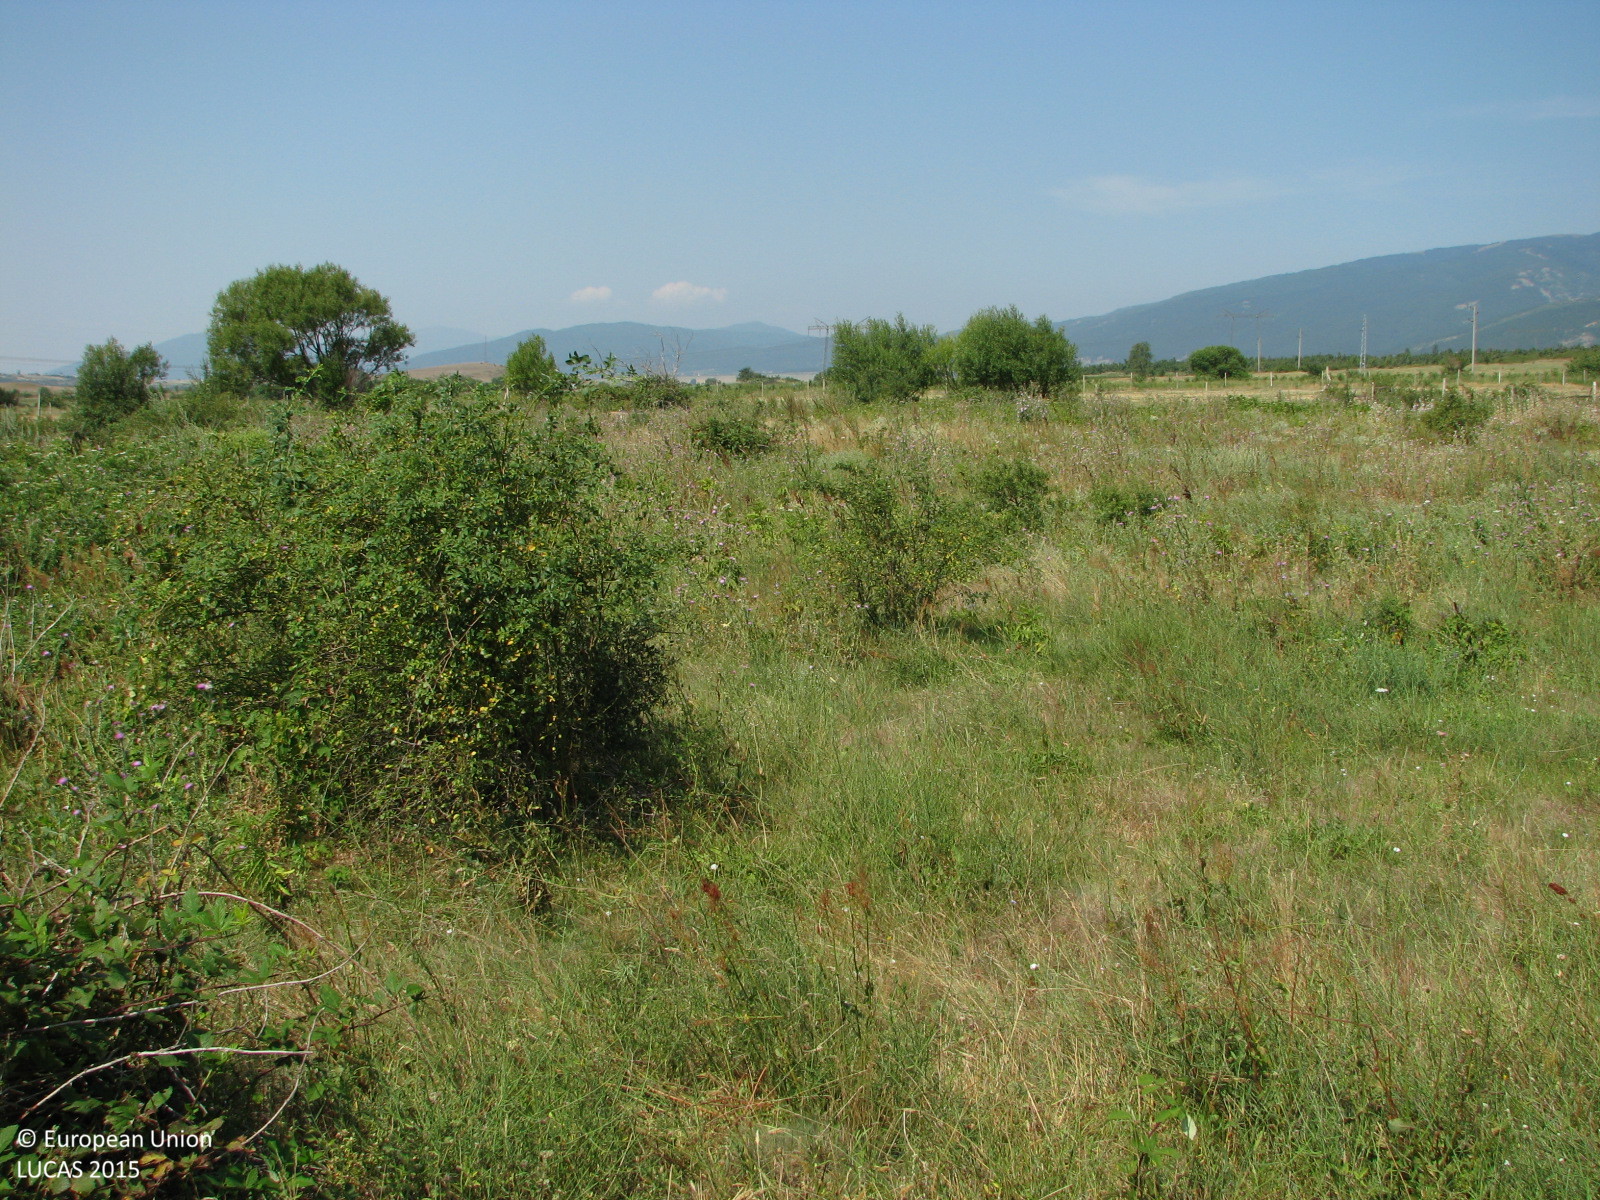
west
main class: Grassland
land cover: Grassland with sparse tree/shrub cover
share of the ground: > 75 %
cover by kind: herbaceous plants 90 %, broadleaved forest trees 5 %, shrubs 5 %
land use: Abandoned areas
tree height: < 5 m
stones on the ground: < 10 %
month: July
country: BG
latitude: 42.6871
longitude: 25.9360
